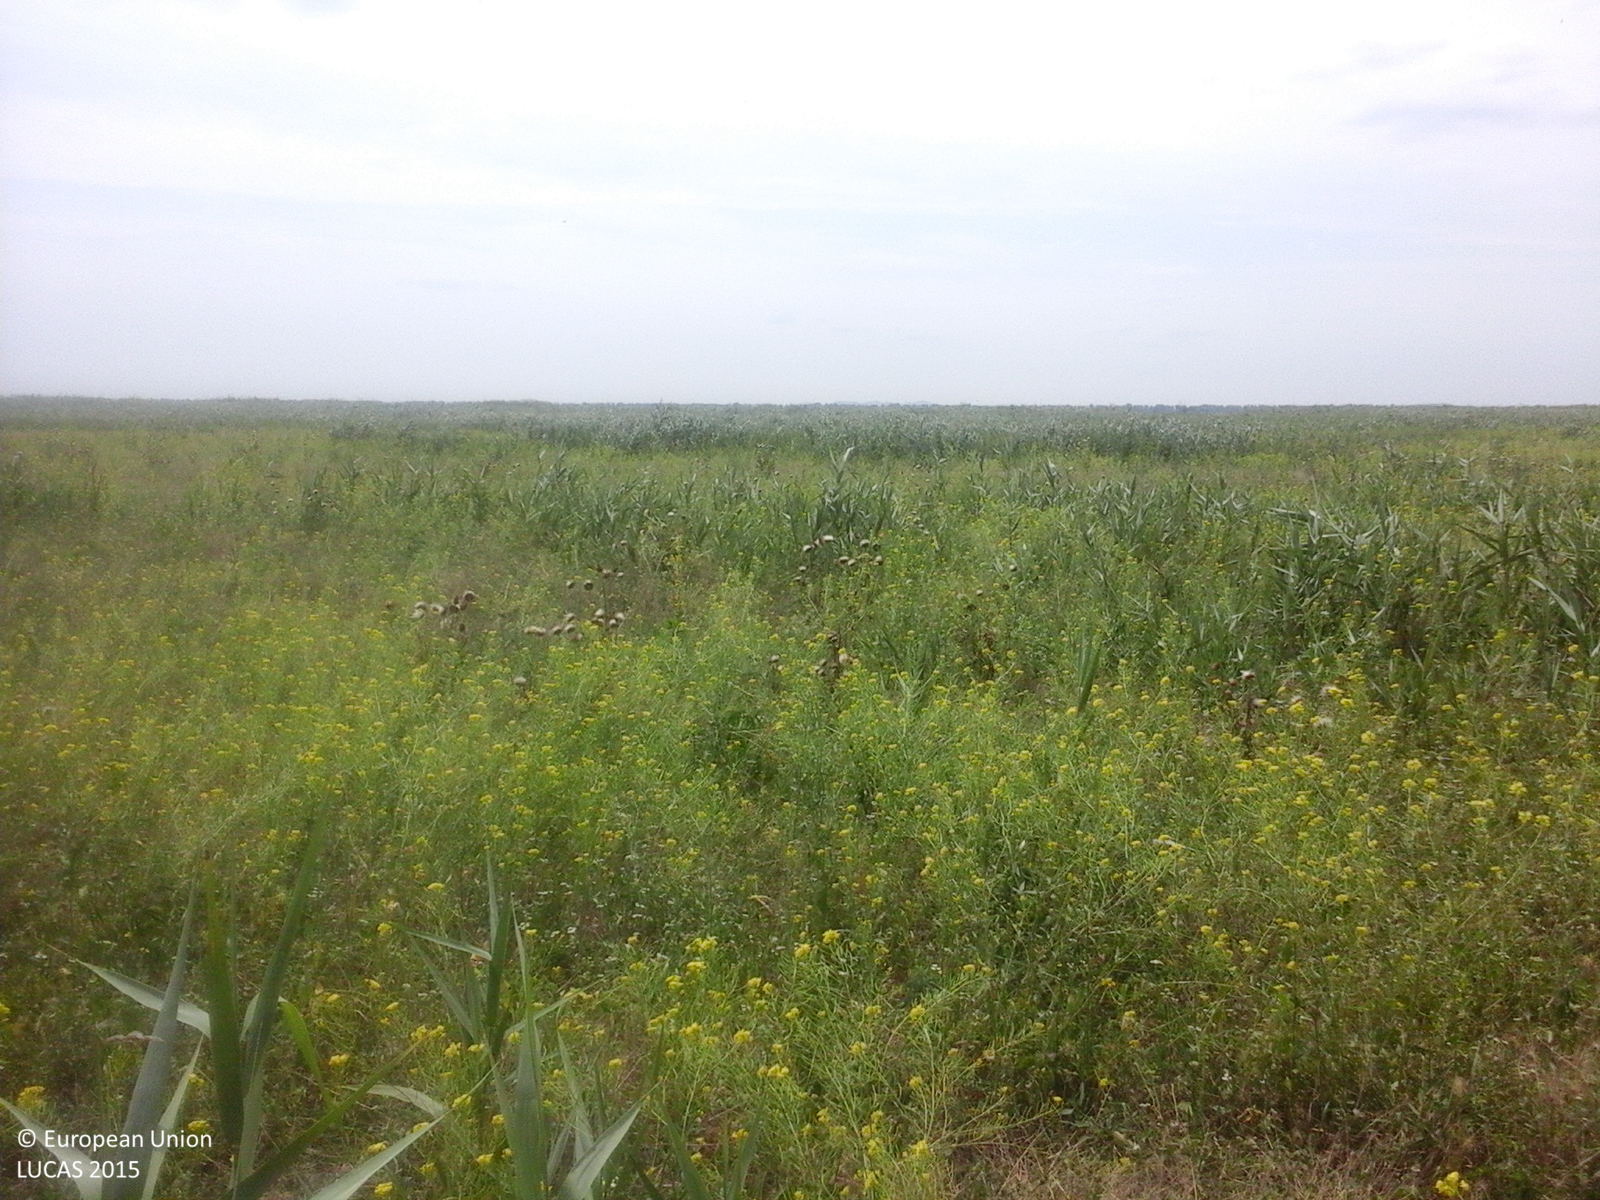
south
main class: Grassland
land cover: Spontaneously vegetated surfaces
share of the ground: > 75 %
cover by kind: herbaceous plants 100 %
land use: Semi-natural and natural areas not in use
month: August
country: RO
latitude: 45.2999
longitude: 29.0634
